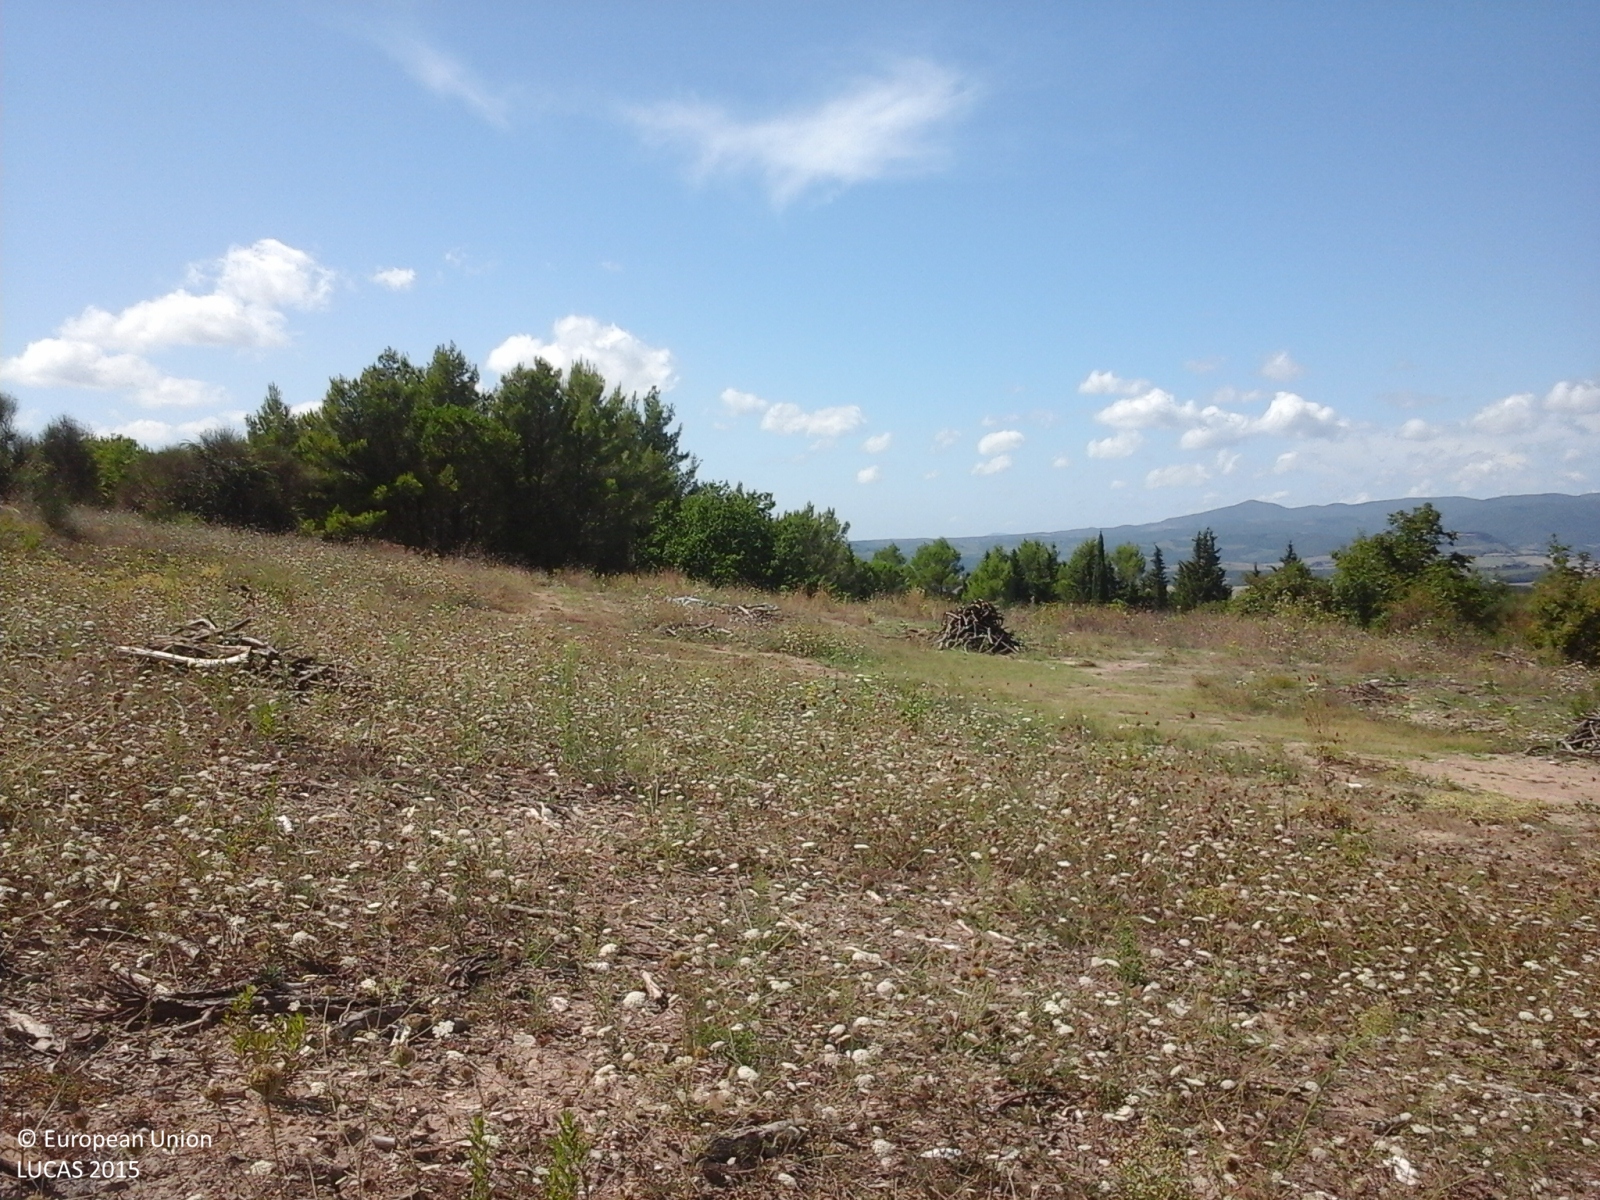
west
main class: Grassland
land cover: Grassland with sparse tree/shrub cover
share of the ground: > 75 %
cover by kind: herbaceous plants 85 %, shrubs 10 %, broadleaved forest trees 5 %
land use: Agriculture (excluding fallow land and kitchen gardens)
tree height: < 5 m
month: August
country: IT
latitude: 43.3015
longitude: 10.7252
